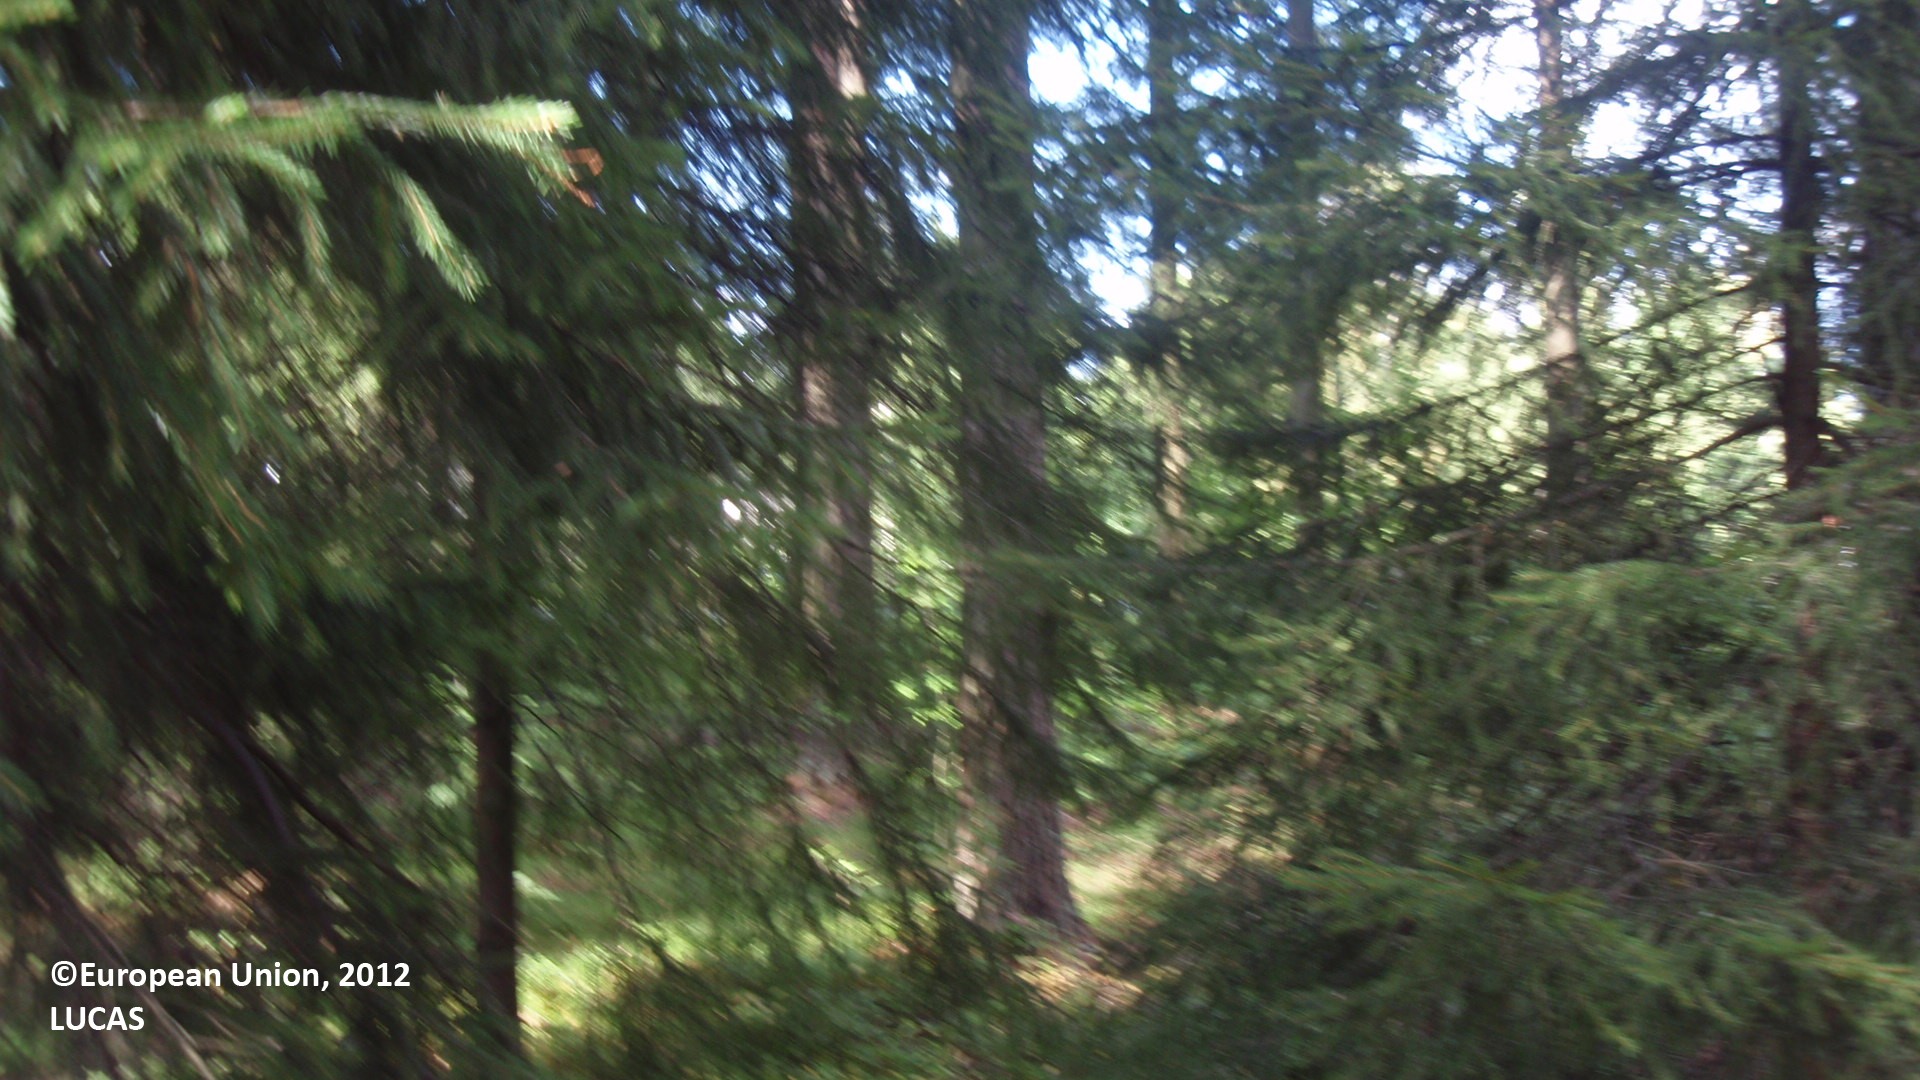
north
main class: Woodland
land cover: Spruce dominated mixed woodland
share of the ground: 50 - 75 %
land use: Forestry
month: August
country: FI
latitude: 60.8494
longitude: 26.5904
